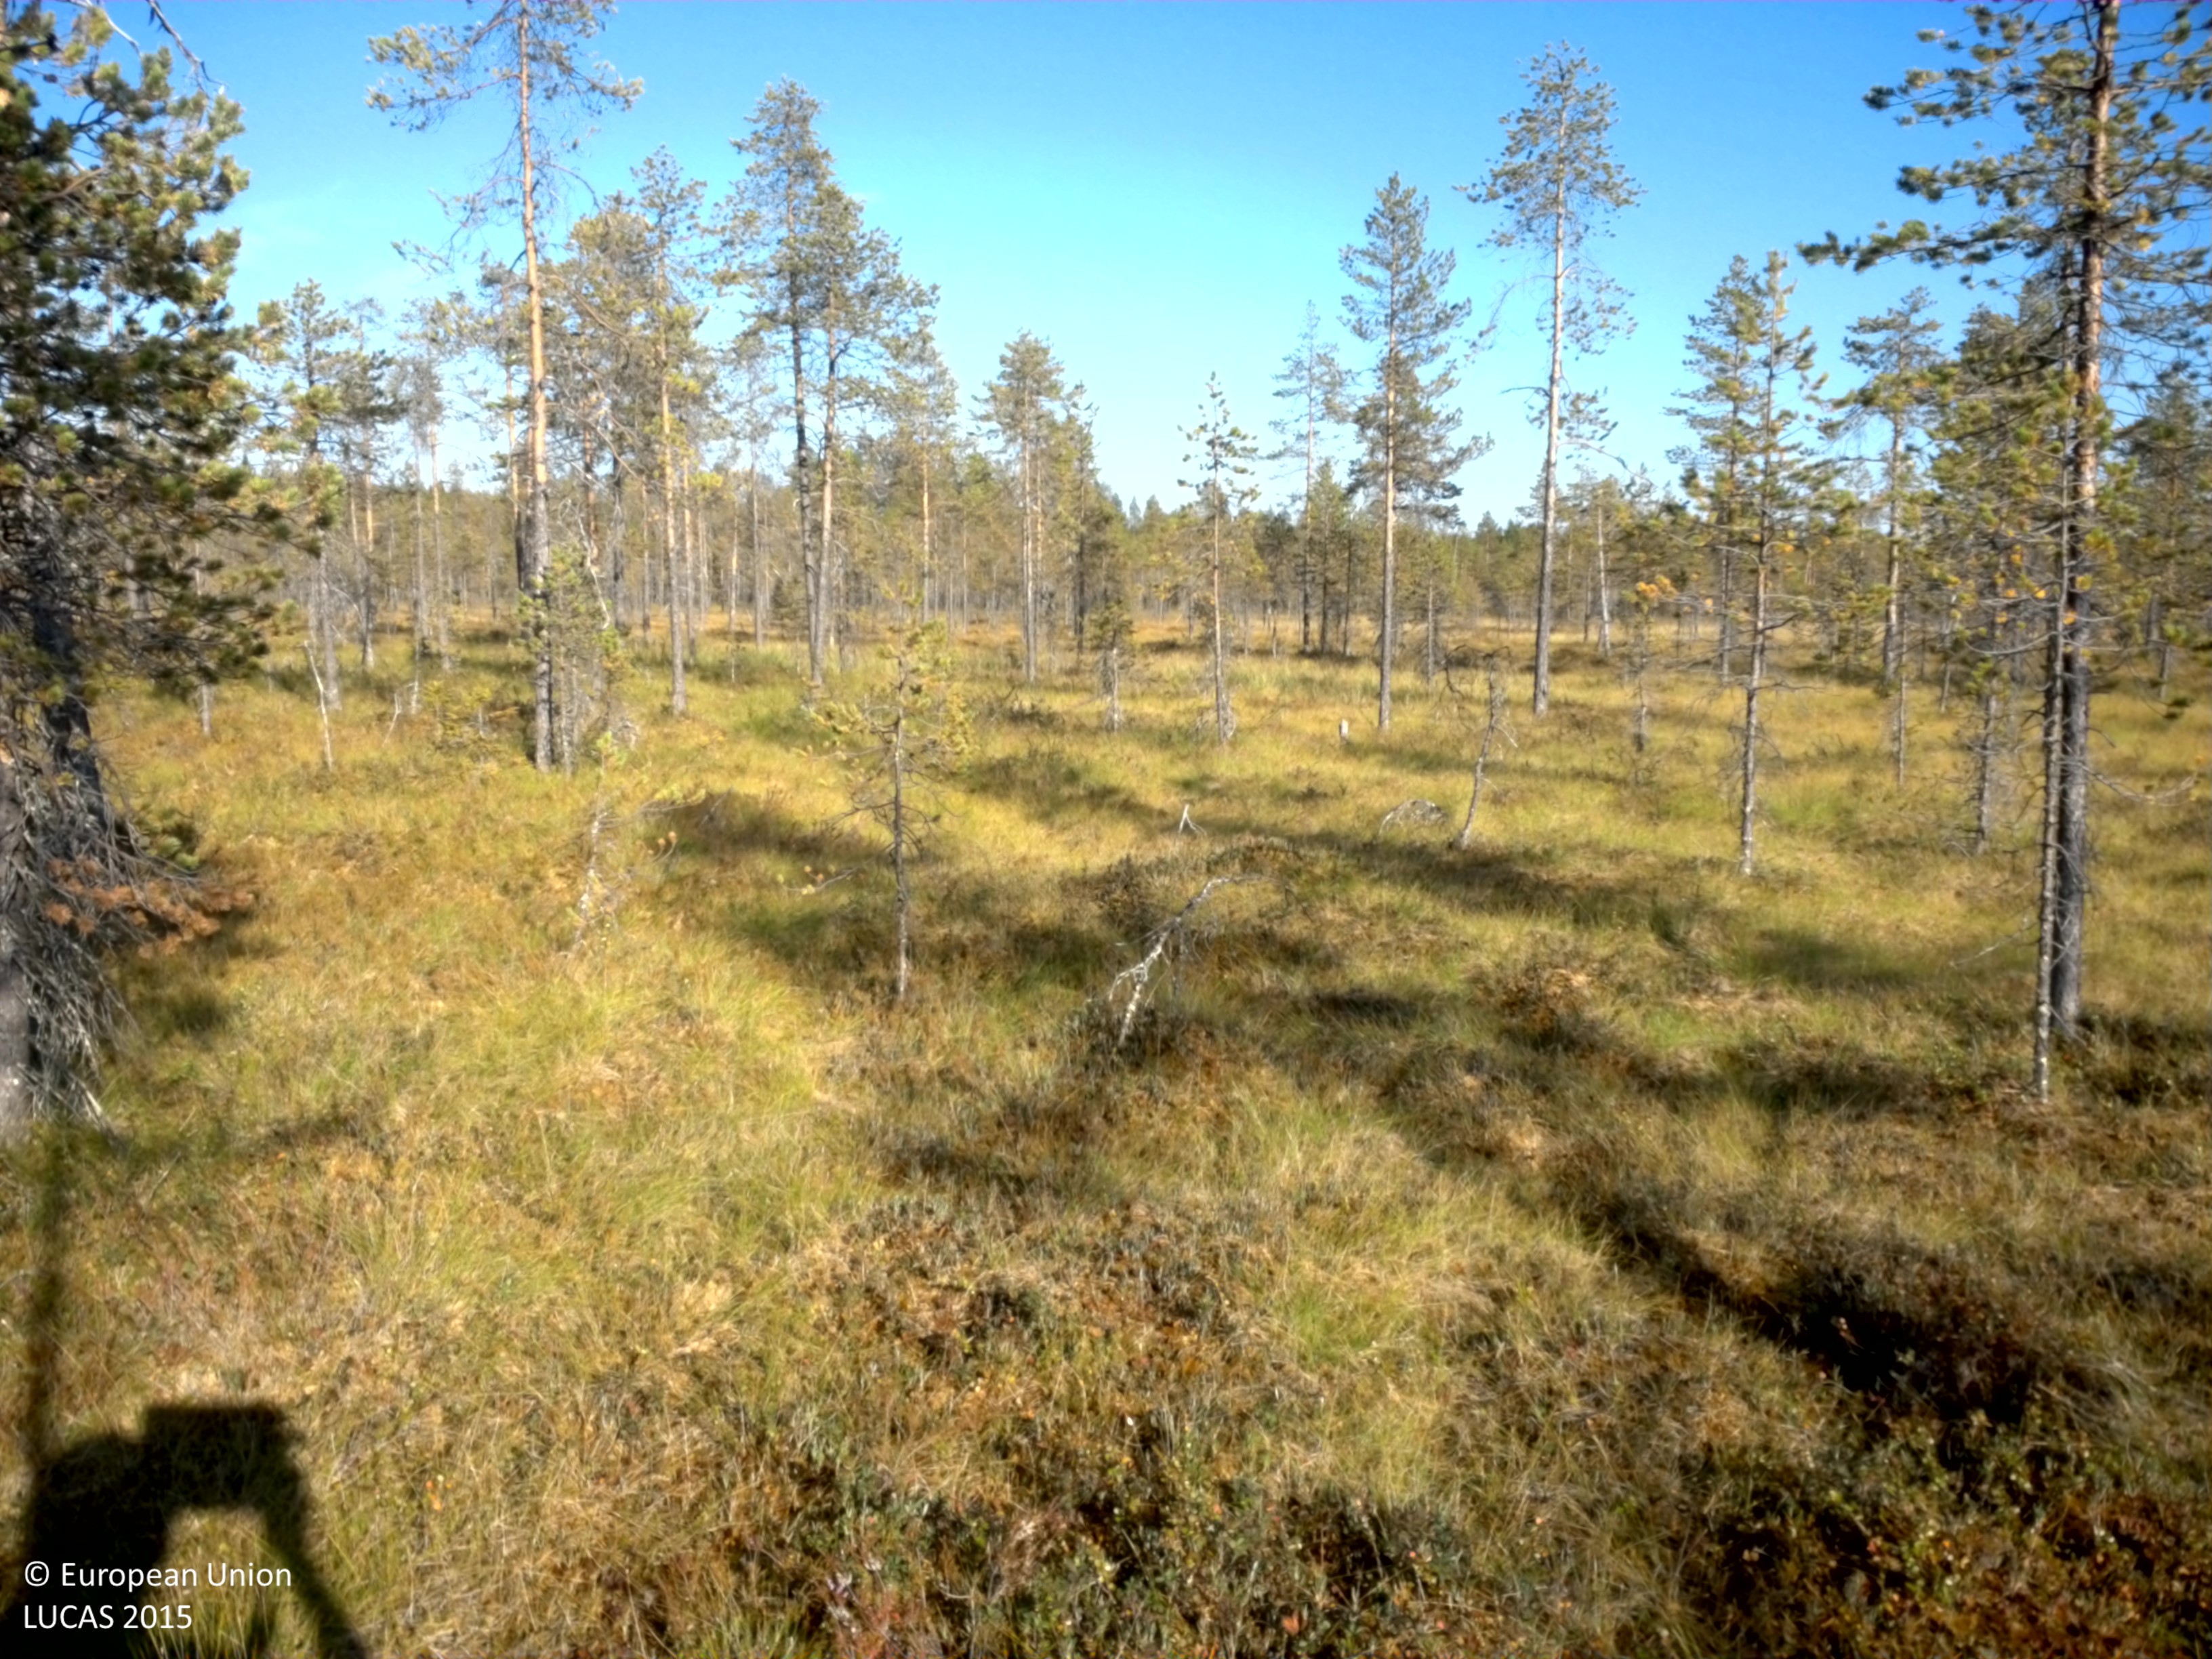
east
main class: Woodland
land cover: Pine dominated coniferous woodland
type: mire and swamp forests
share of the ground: 10 - 25 %
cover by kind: herbaceous plants 35 %, lichens and mosses 35 %, shrubs 20 %, coniferous forest trees 10 %
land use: Semi-natural and natural areas not in use
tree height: > 5 m
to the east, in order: Pine dominated coniferous woodland; Other mixed woodland; Pine dominated mixed woodland; Other mixed woodland
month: August
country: SE
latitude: 64.7099
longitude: 16.7007
